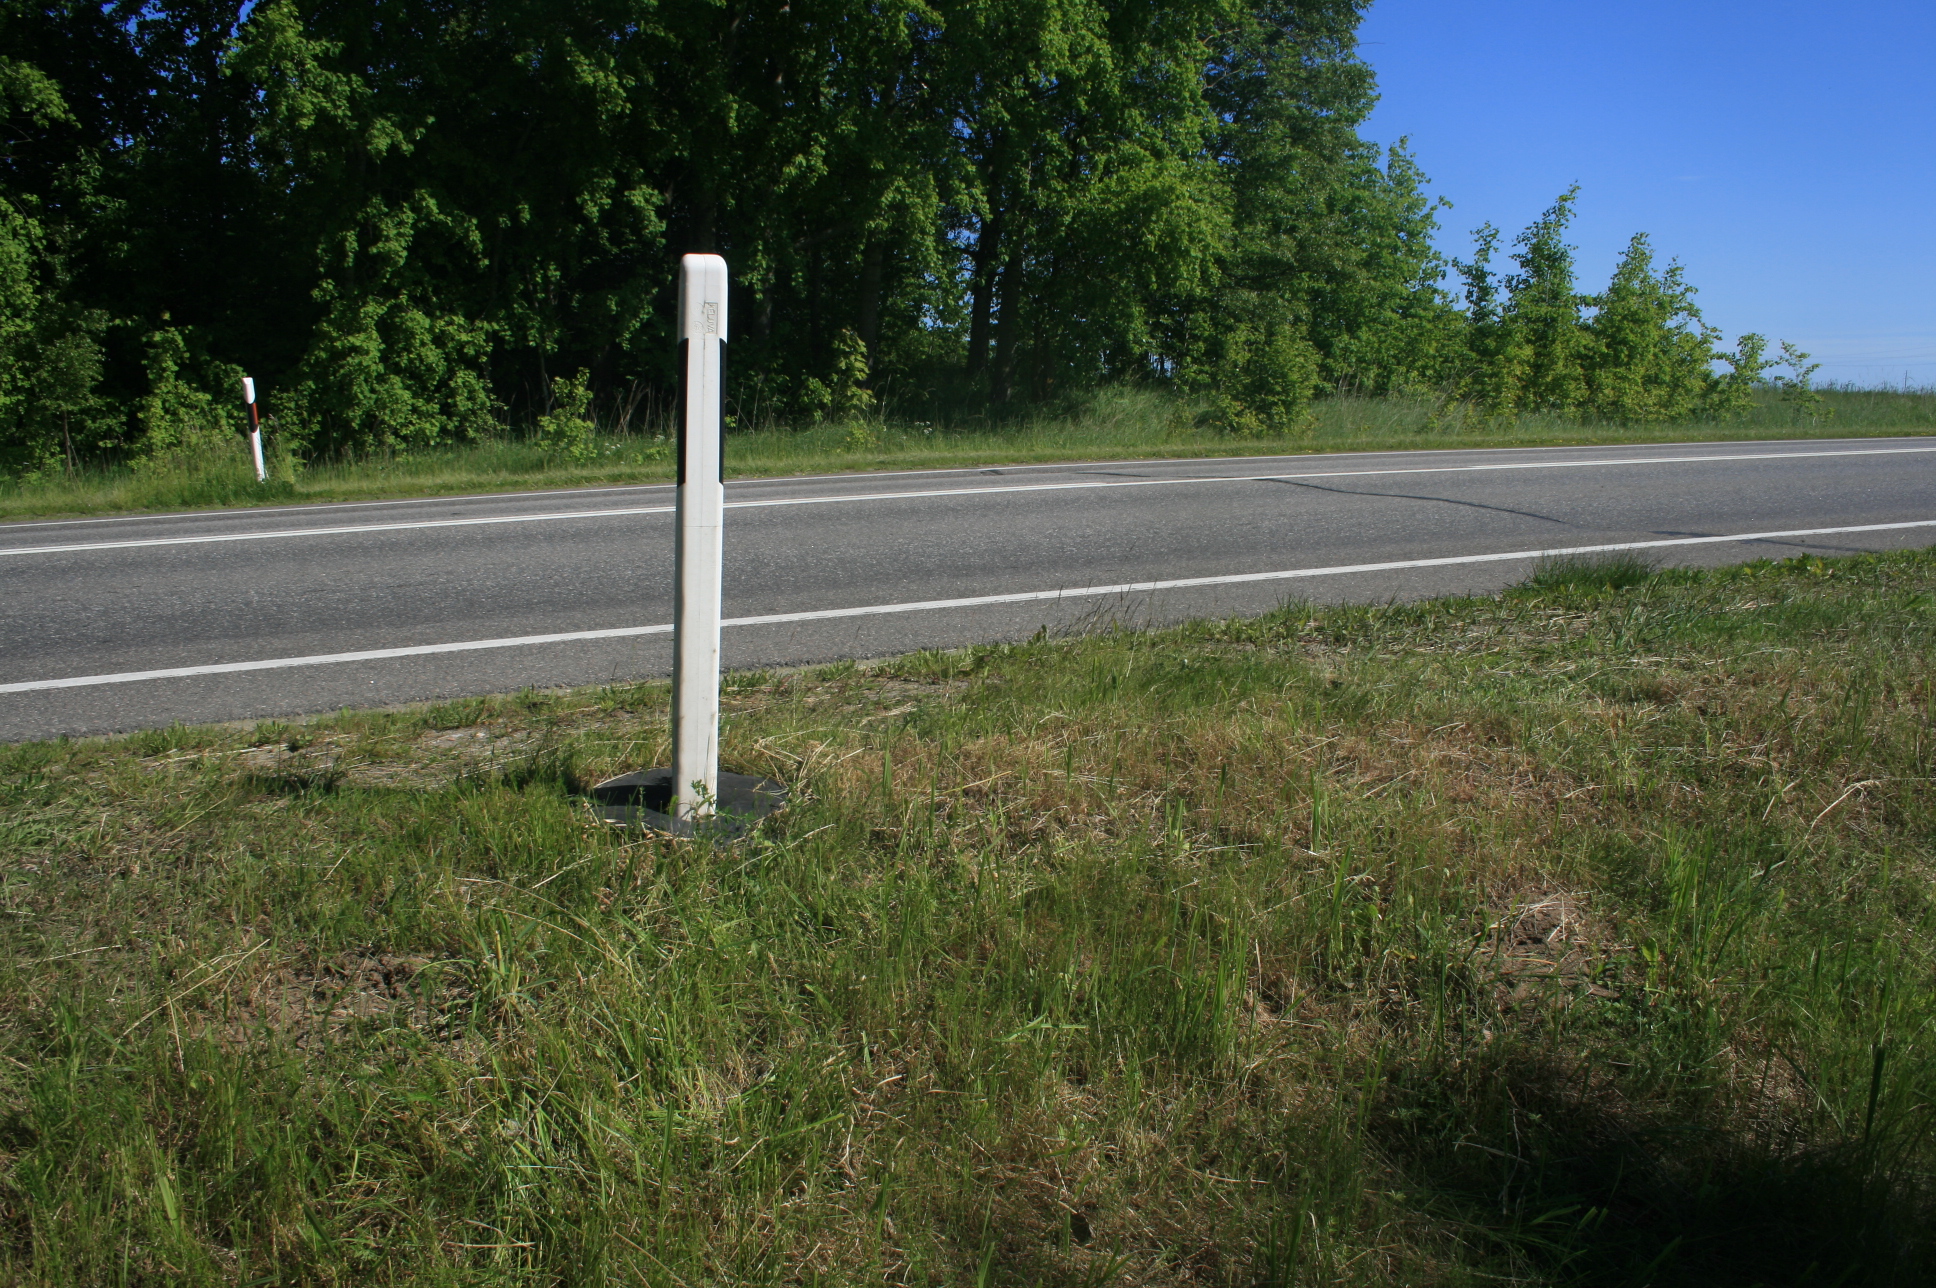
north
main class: Grassland
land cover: Grassland without tree/shrub cover
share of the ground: > 75 %
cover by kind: herbaceous plants 100 %
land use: Road transport
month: June
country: LT
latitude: 55.9217
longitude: 21.5183
